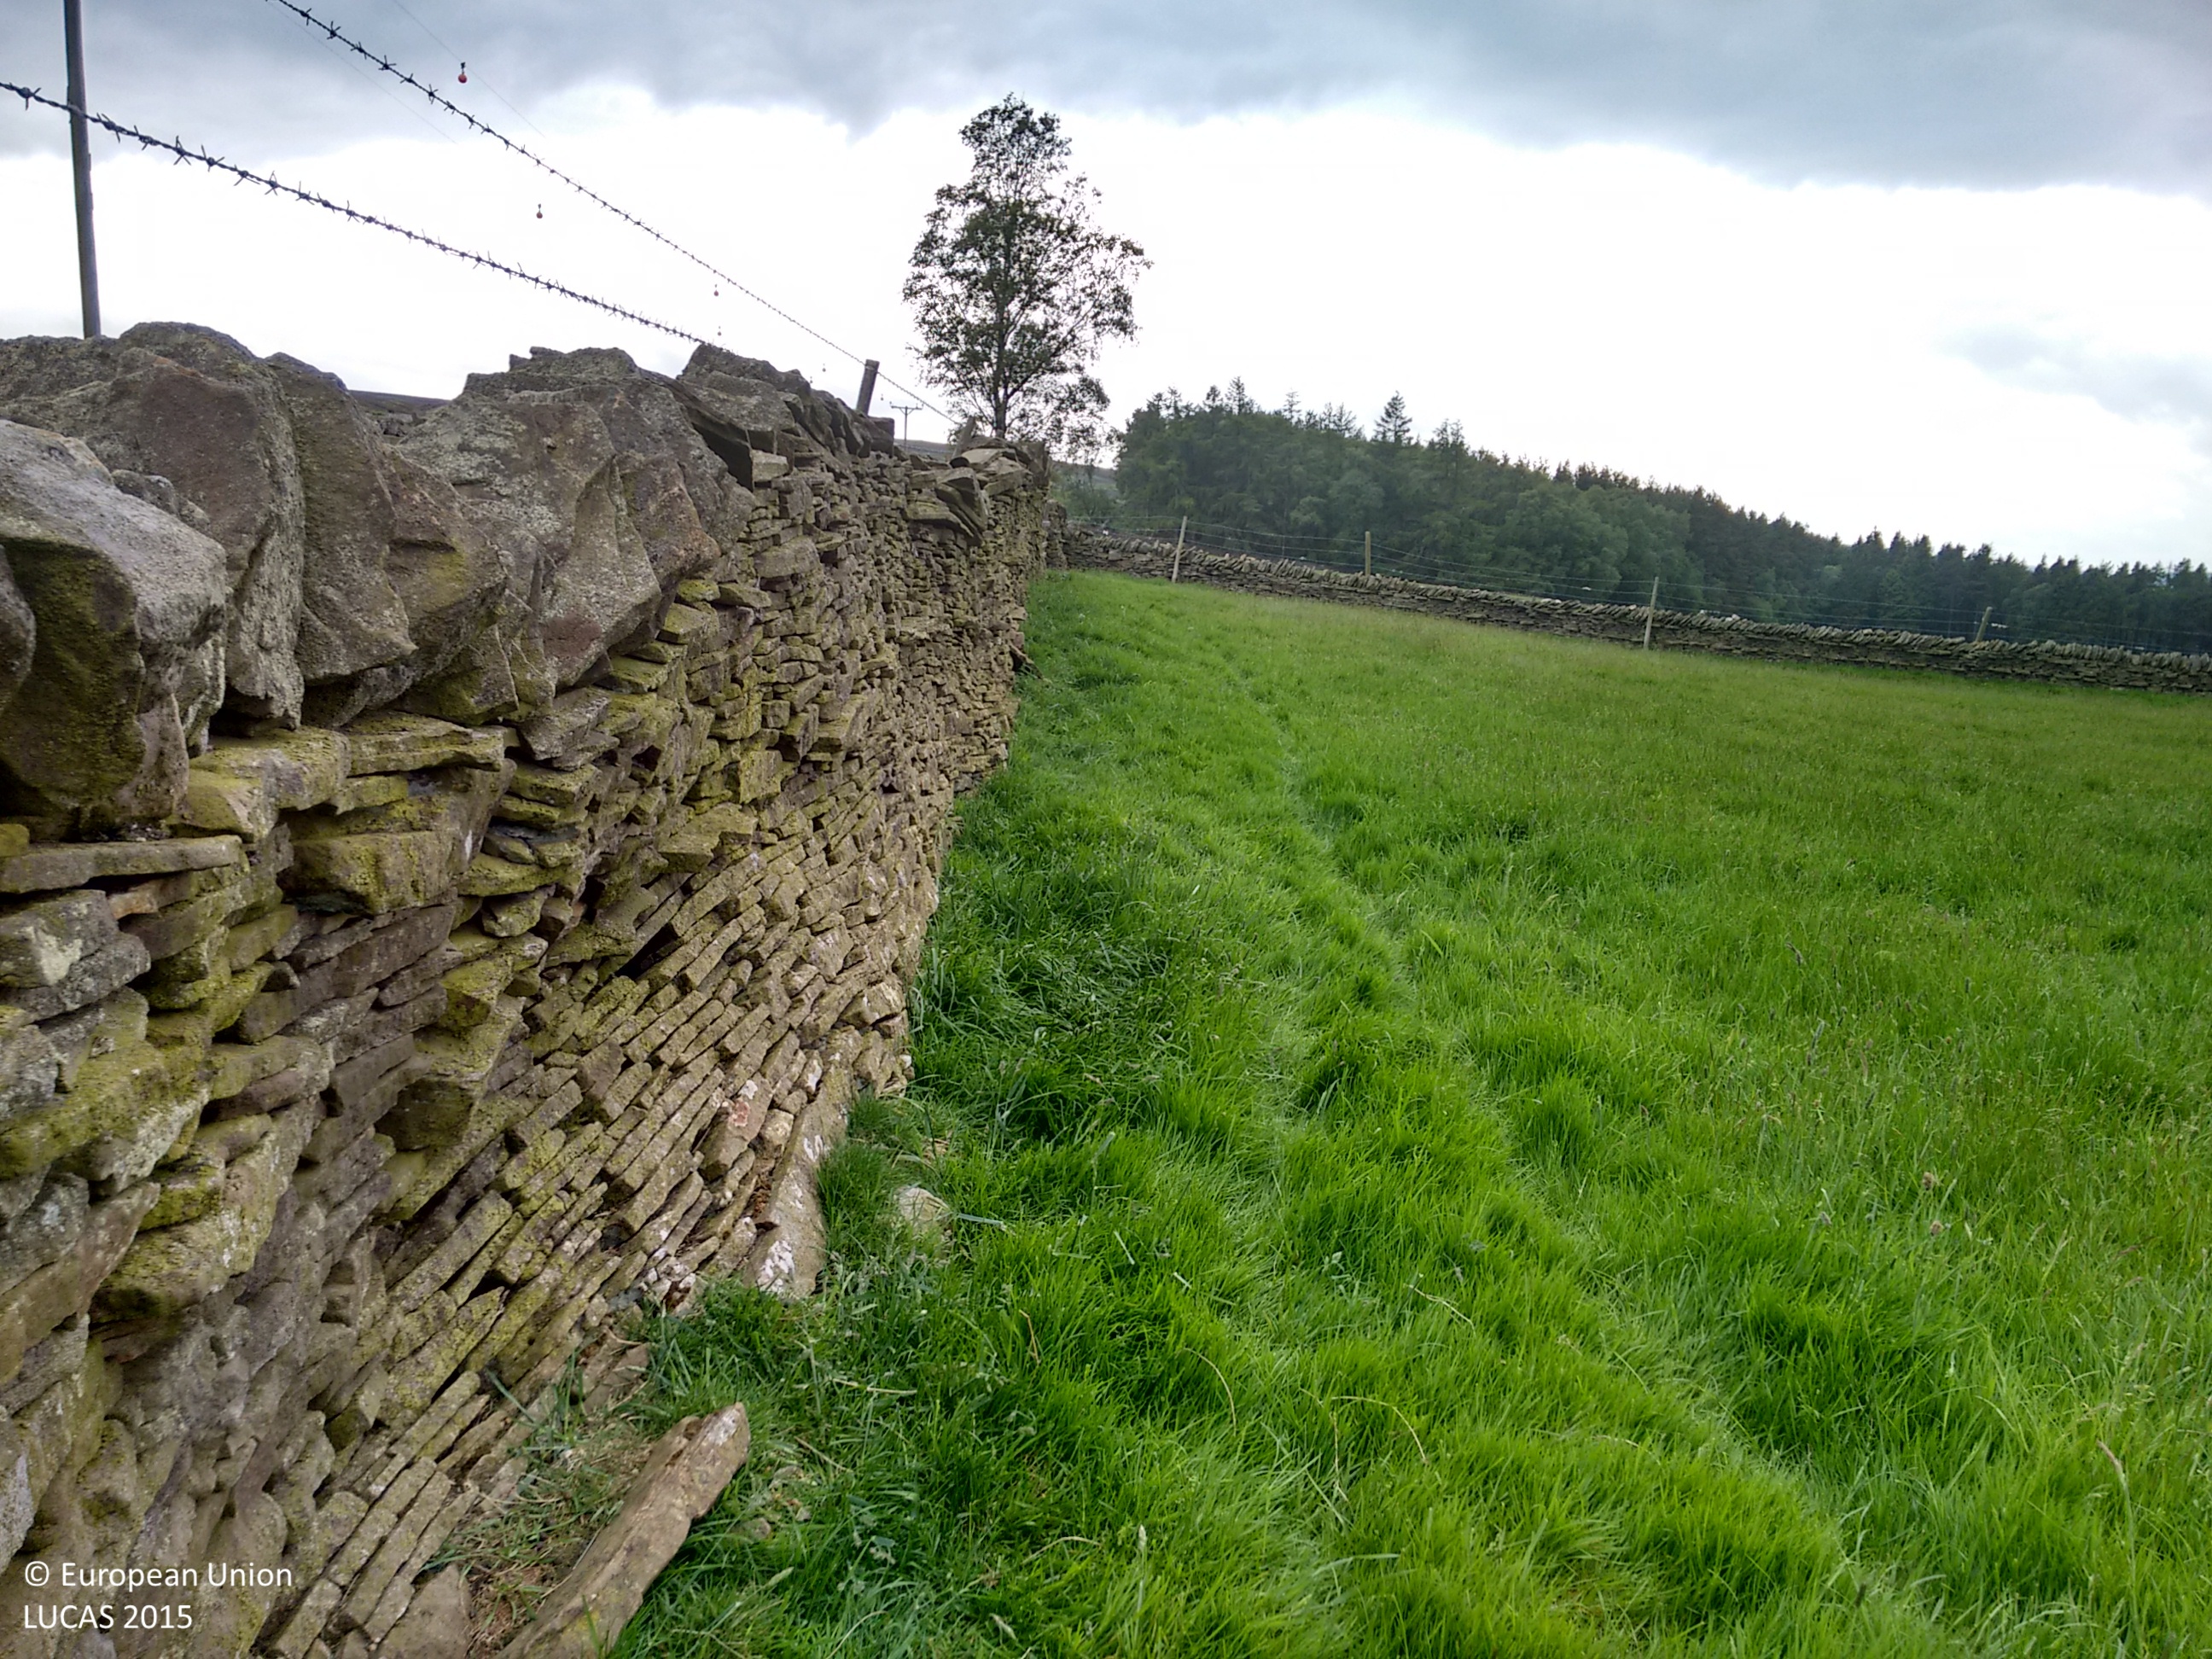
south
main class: Shrubland
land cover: Shrubland without tree cover
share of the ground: > 75 %
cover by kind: shrubs 90 %, herbaceous plants 10 %
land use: Agriculture (excluding fallow land and kitchen gardens)
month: June
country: GB
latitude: 54.8576
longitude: -2.0032
